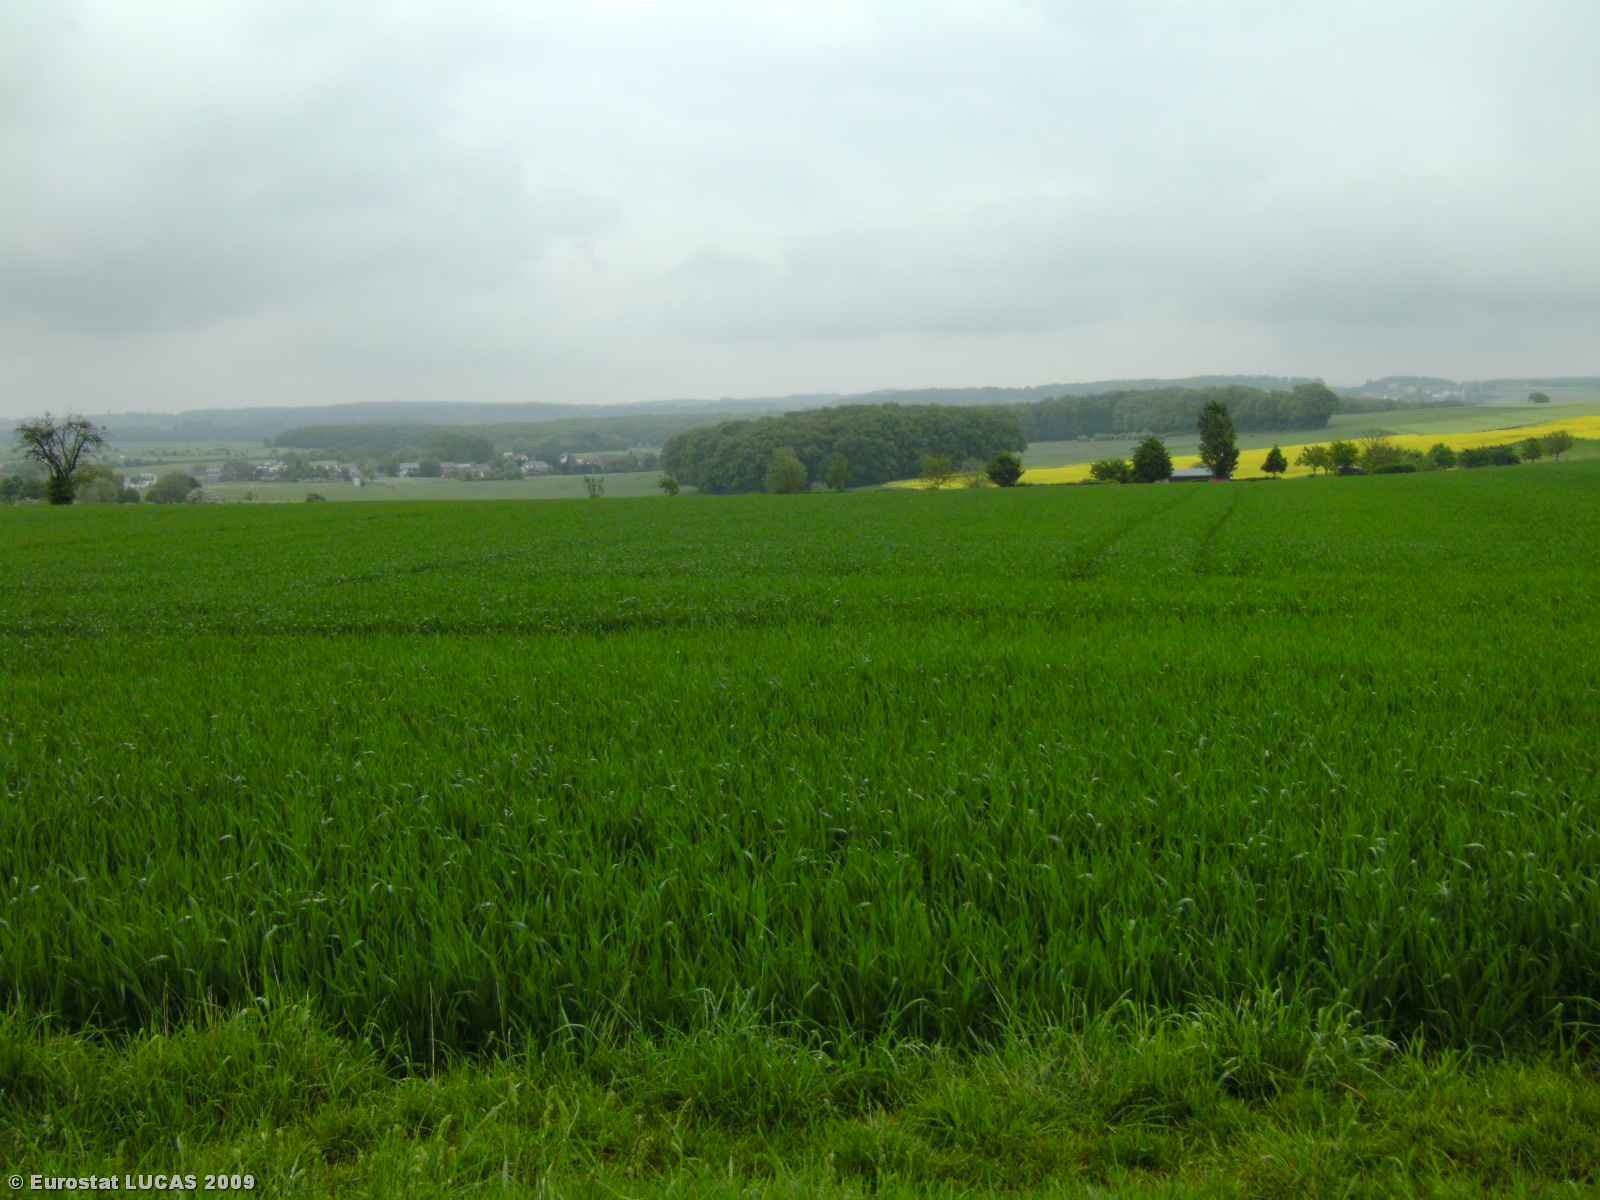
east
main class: Cropland
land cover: Maize
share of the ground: < 10 %
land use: Agriculture (excluding fallow land and kitchen gardens)
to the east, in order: Maize; Tracks; Common wheat; Ditches and canals; Grass margins; Paved roads, cycling and walking lanes; Grass margins; Abandoned hedges; Fences; Artificial constructions in urban areas; Fences; Managed hedges; Grassland without tree/shrub cover
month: May
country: LU
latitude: 49.7810
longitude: 6.2637
